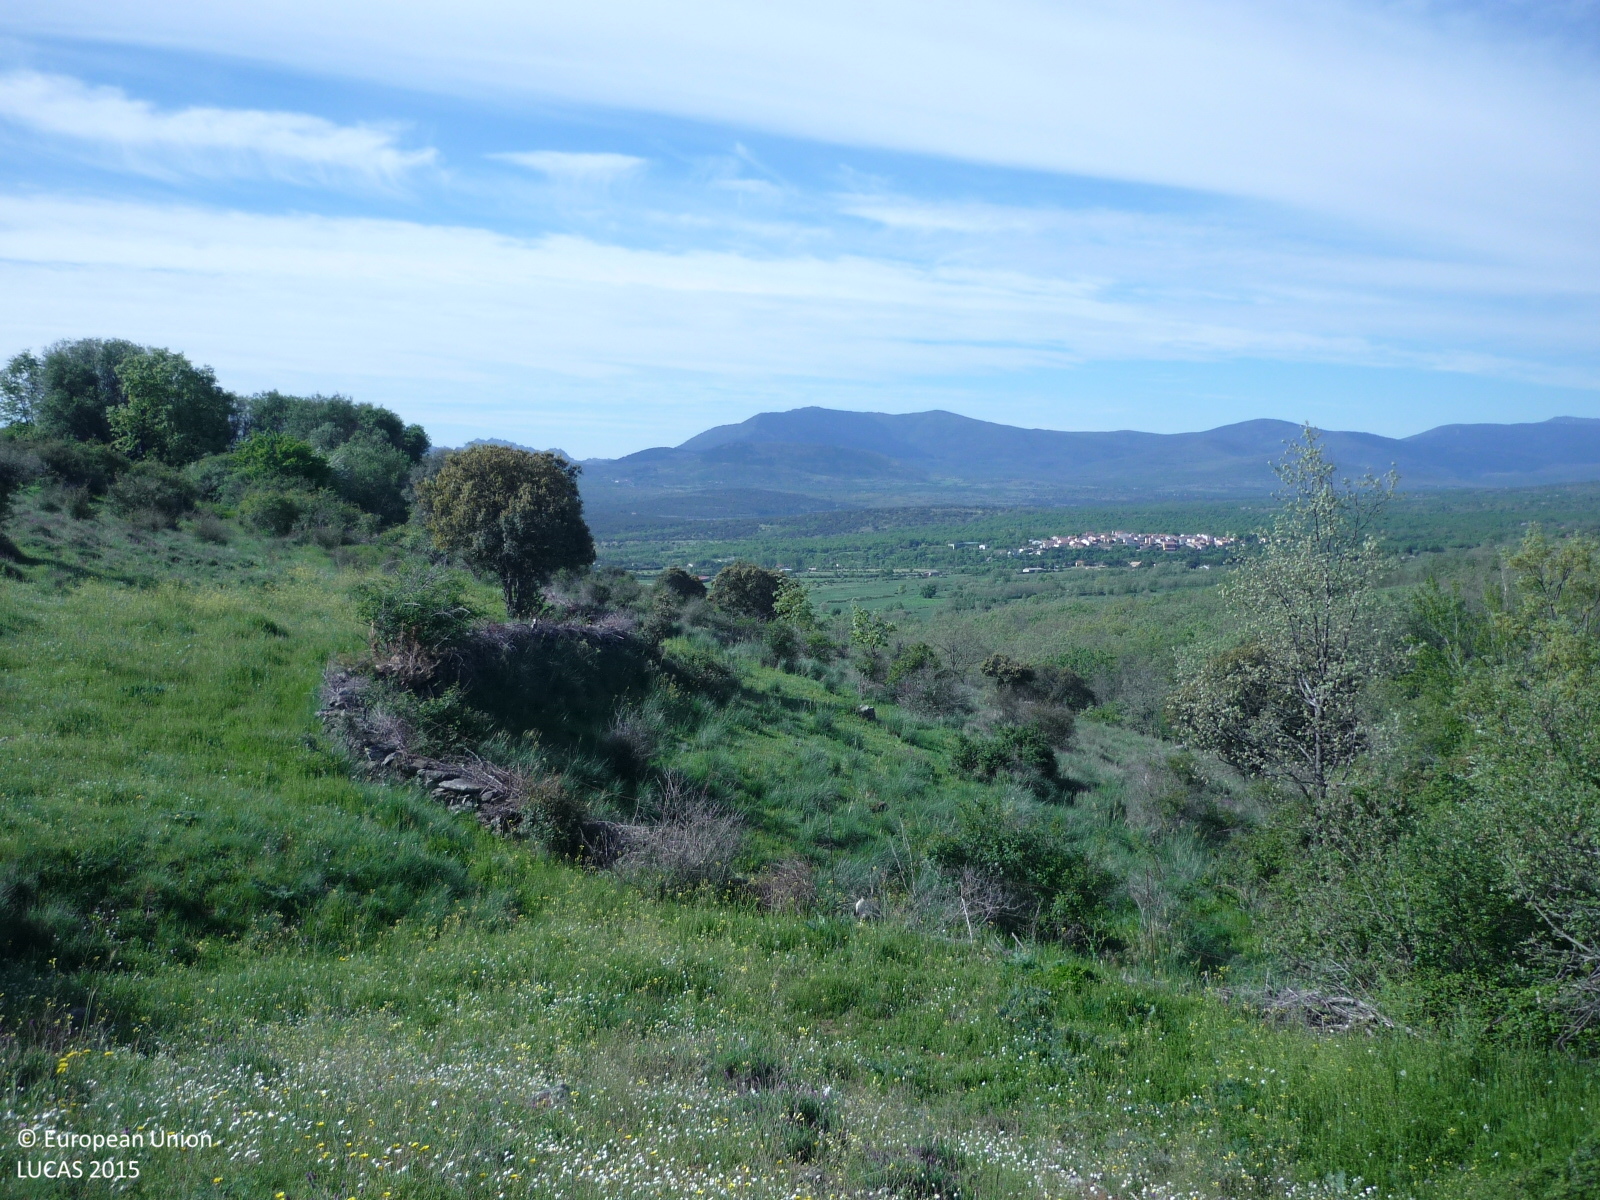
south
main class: Grassland
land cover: Grassland with sparse tree/shrub cover
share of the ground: > 75 %
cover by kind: herbaceous plants 85 %, shrubs 10 %, broadleaved forest trees 5 %
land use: Agriculture (excluding fallow land and kitchen gardens)
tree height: < 5 m
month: May
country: ES
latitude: 41.0280
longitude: -3.6628
